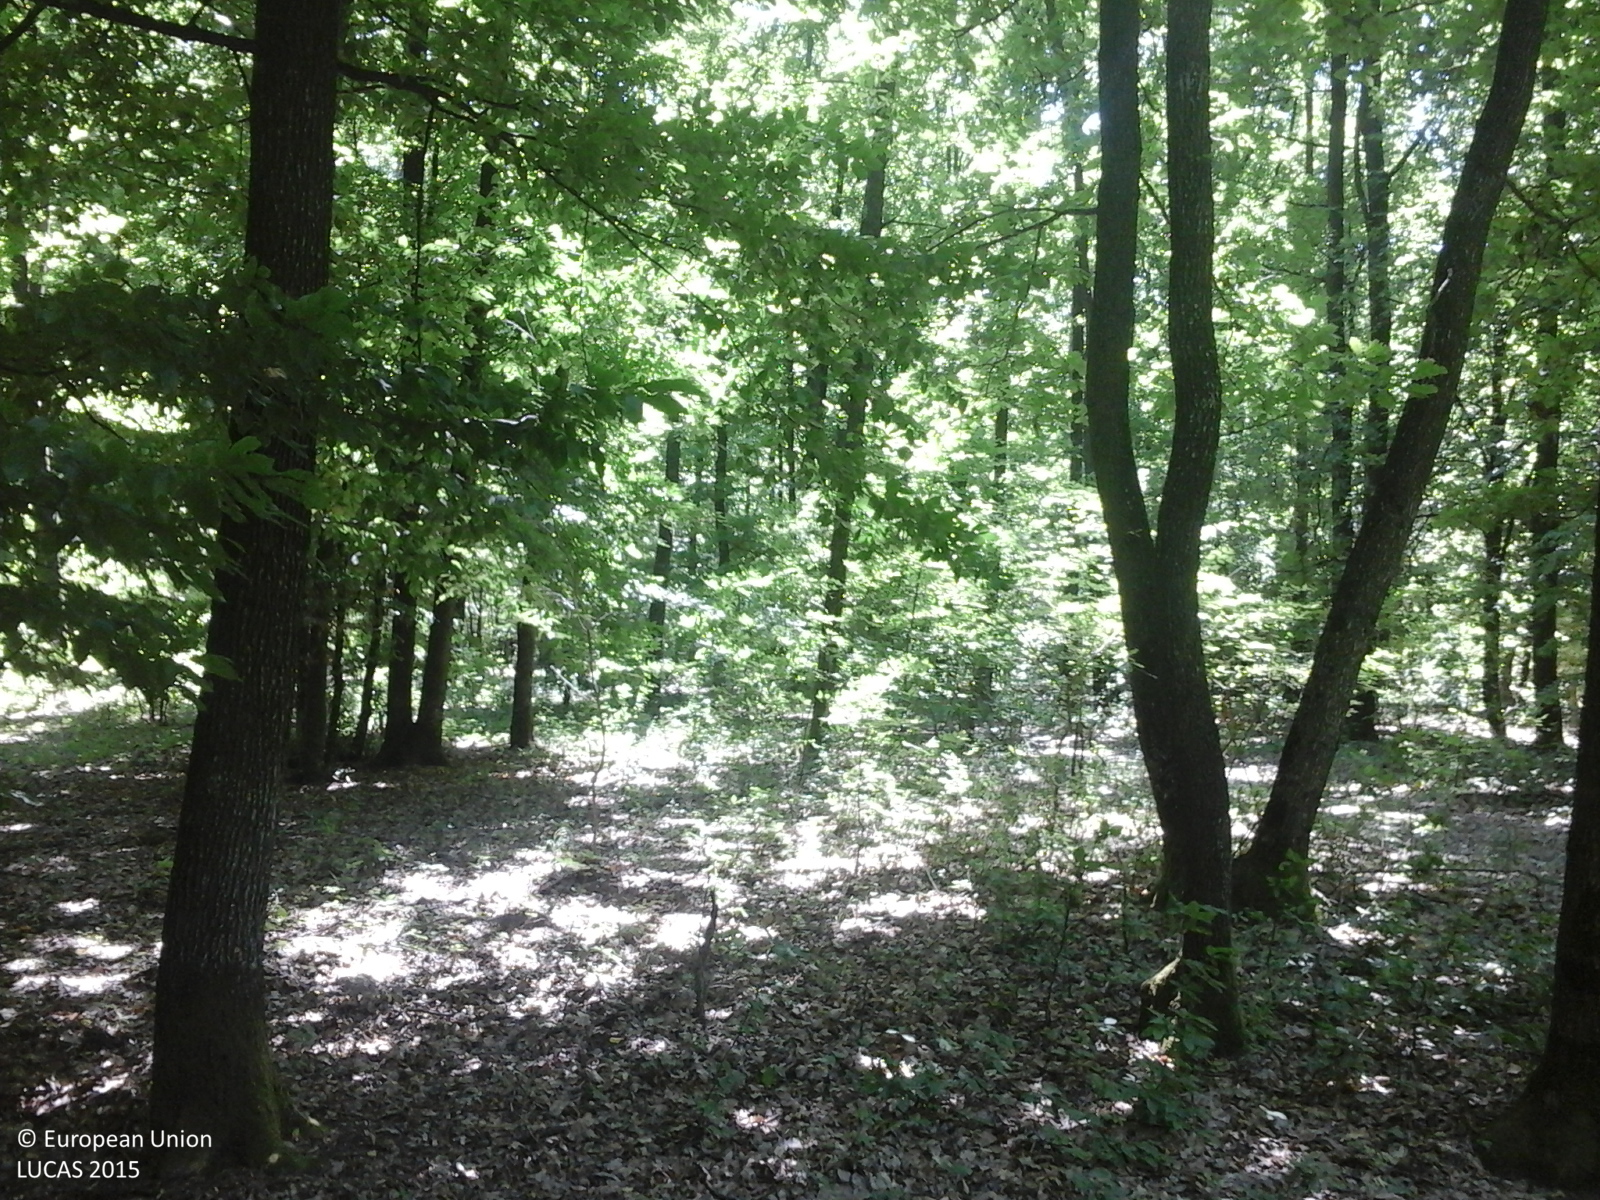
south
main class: Woodland
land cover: Broadleaved woodland
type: acidophilous oak and oak-birch forest
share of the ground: > 75 %
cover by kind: broadleaved forest trees 100 %
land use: Forestry
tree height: > 5 m
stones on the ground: 10 - 25 %
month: June
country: RO
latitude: 45.0759
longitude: 26.1562
